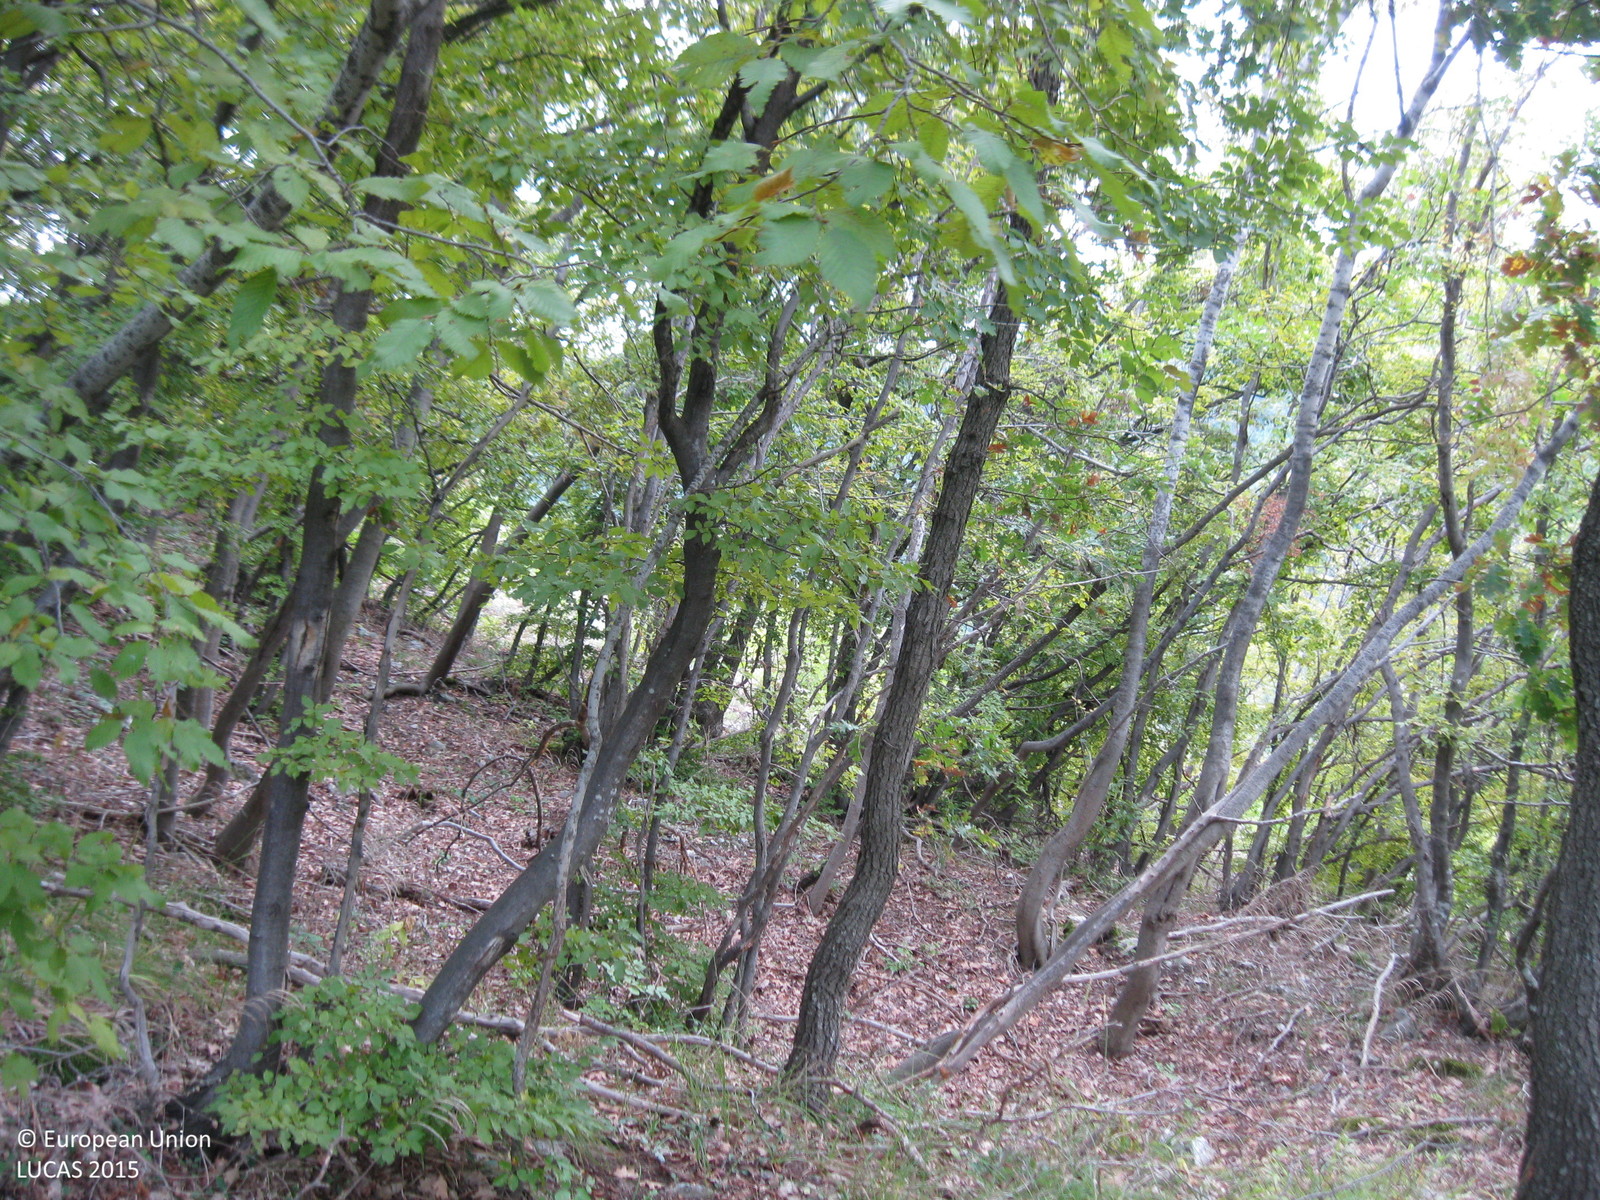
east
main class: Woodland
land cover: Broadleaved woodland
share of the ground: > 75 %
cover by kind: broadleaved forest trees 100 %
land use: Forestry
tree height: < 5 m
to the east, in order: Broadleaved woodland; Shrubland without tree cover
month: October
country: BG
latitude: 42.0505
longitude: 24.7054
